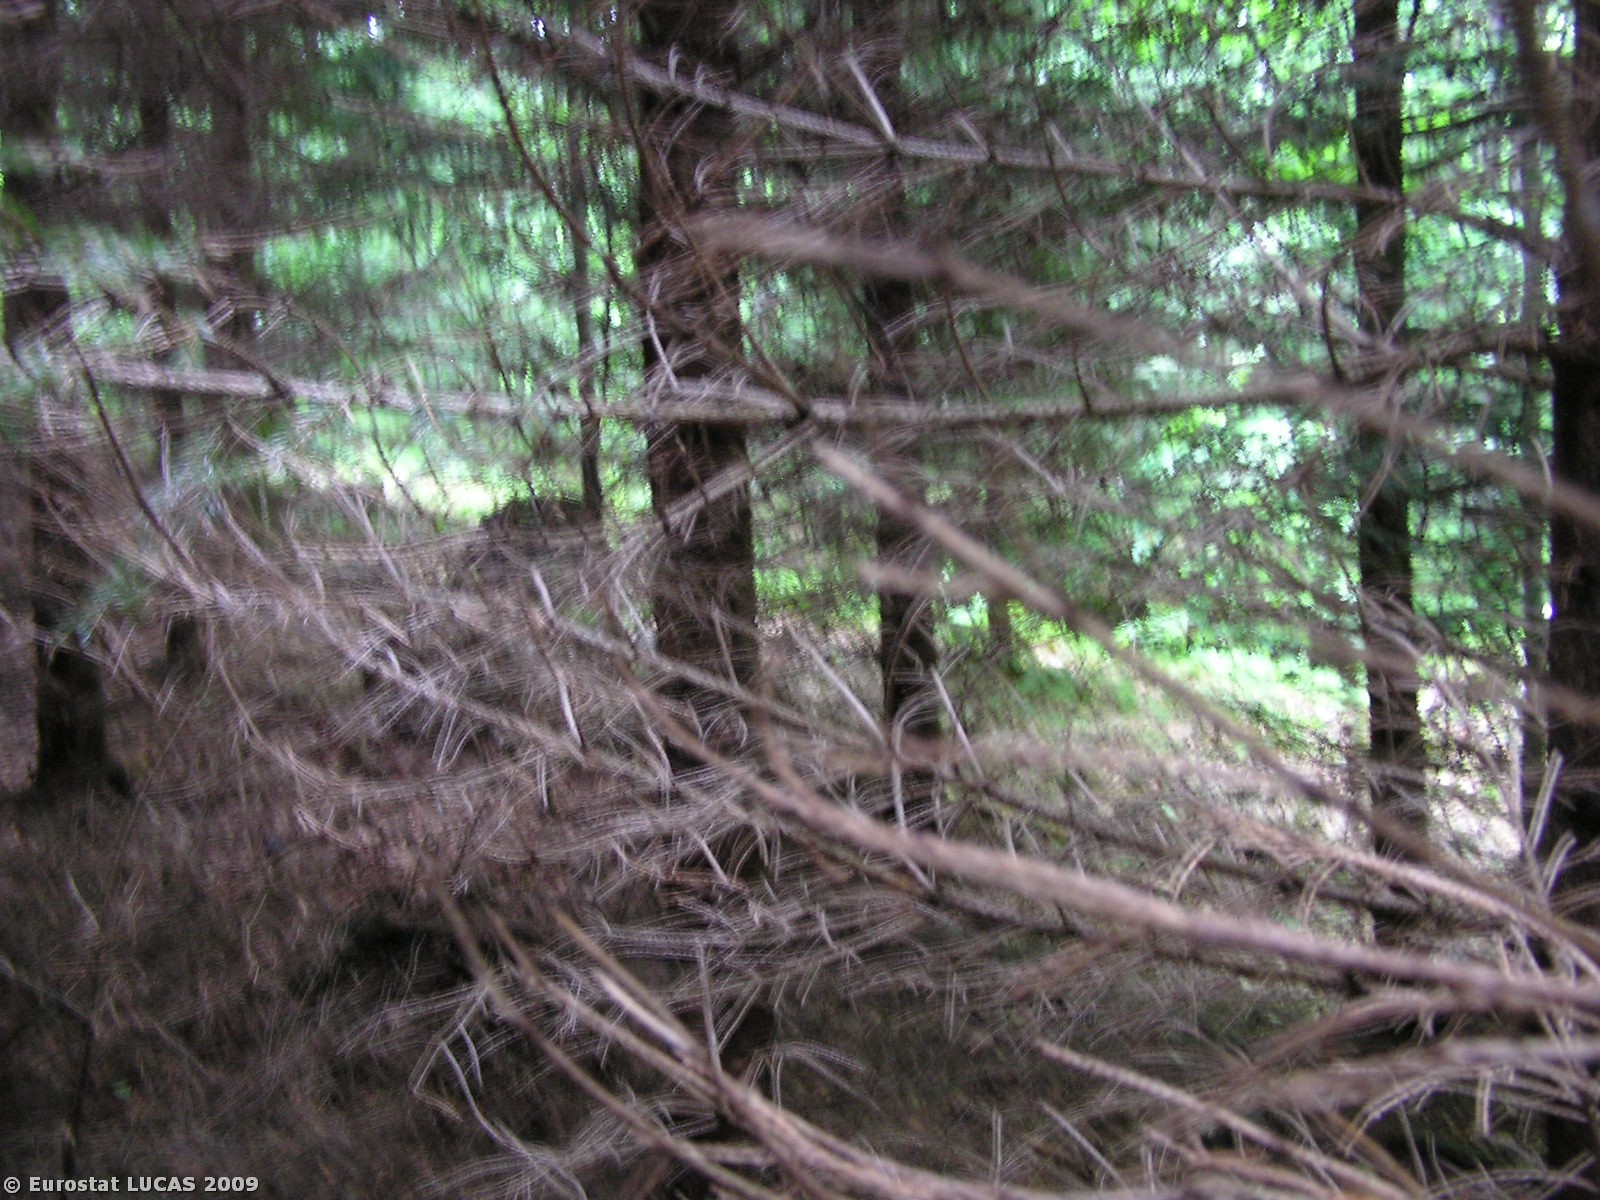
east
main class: Woodland
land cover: Coniferous woodland
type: hemiboreal forest and nemoral coniferous forest and mixed broadleaved-coniferous forest
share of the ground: > 75 %
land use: Forestry
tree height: > 5 m
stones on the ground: < 10 %
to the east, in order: Coniferous woodland; Tracks; Broadleaved woodland; Tracks; Mixed woodland; Rivers and streams; Mixed woodland; Rivers and streams; Mixed woodland; Broadleaved woodland; Mixed woodland; Rivers and streams; Coniferous woodland
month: July
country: CZ
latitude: 50.2486
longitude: 17.1487
